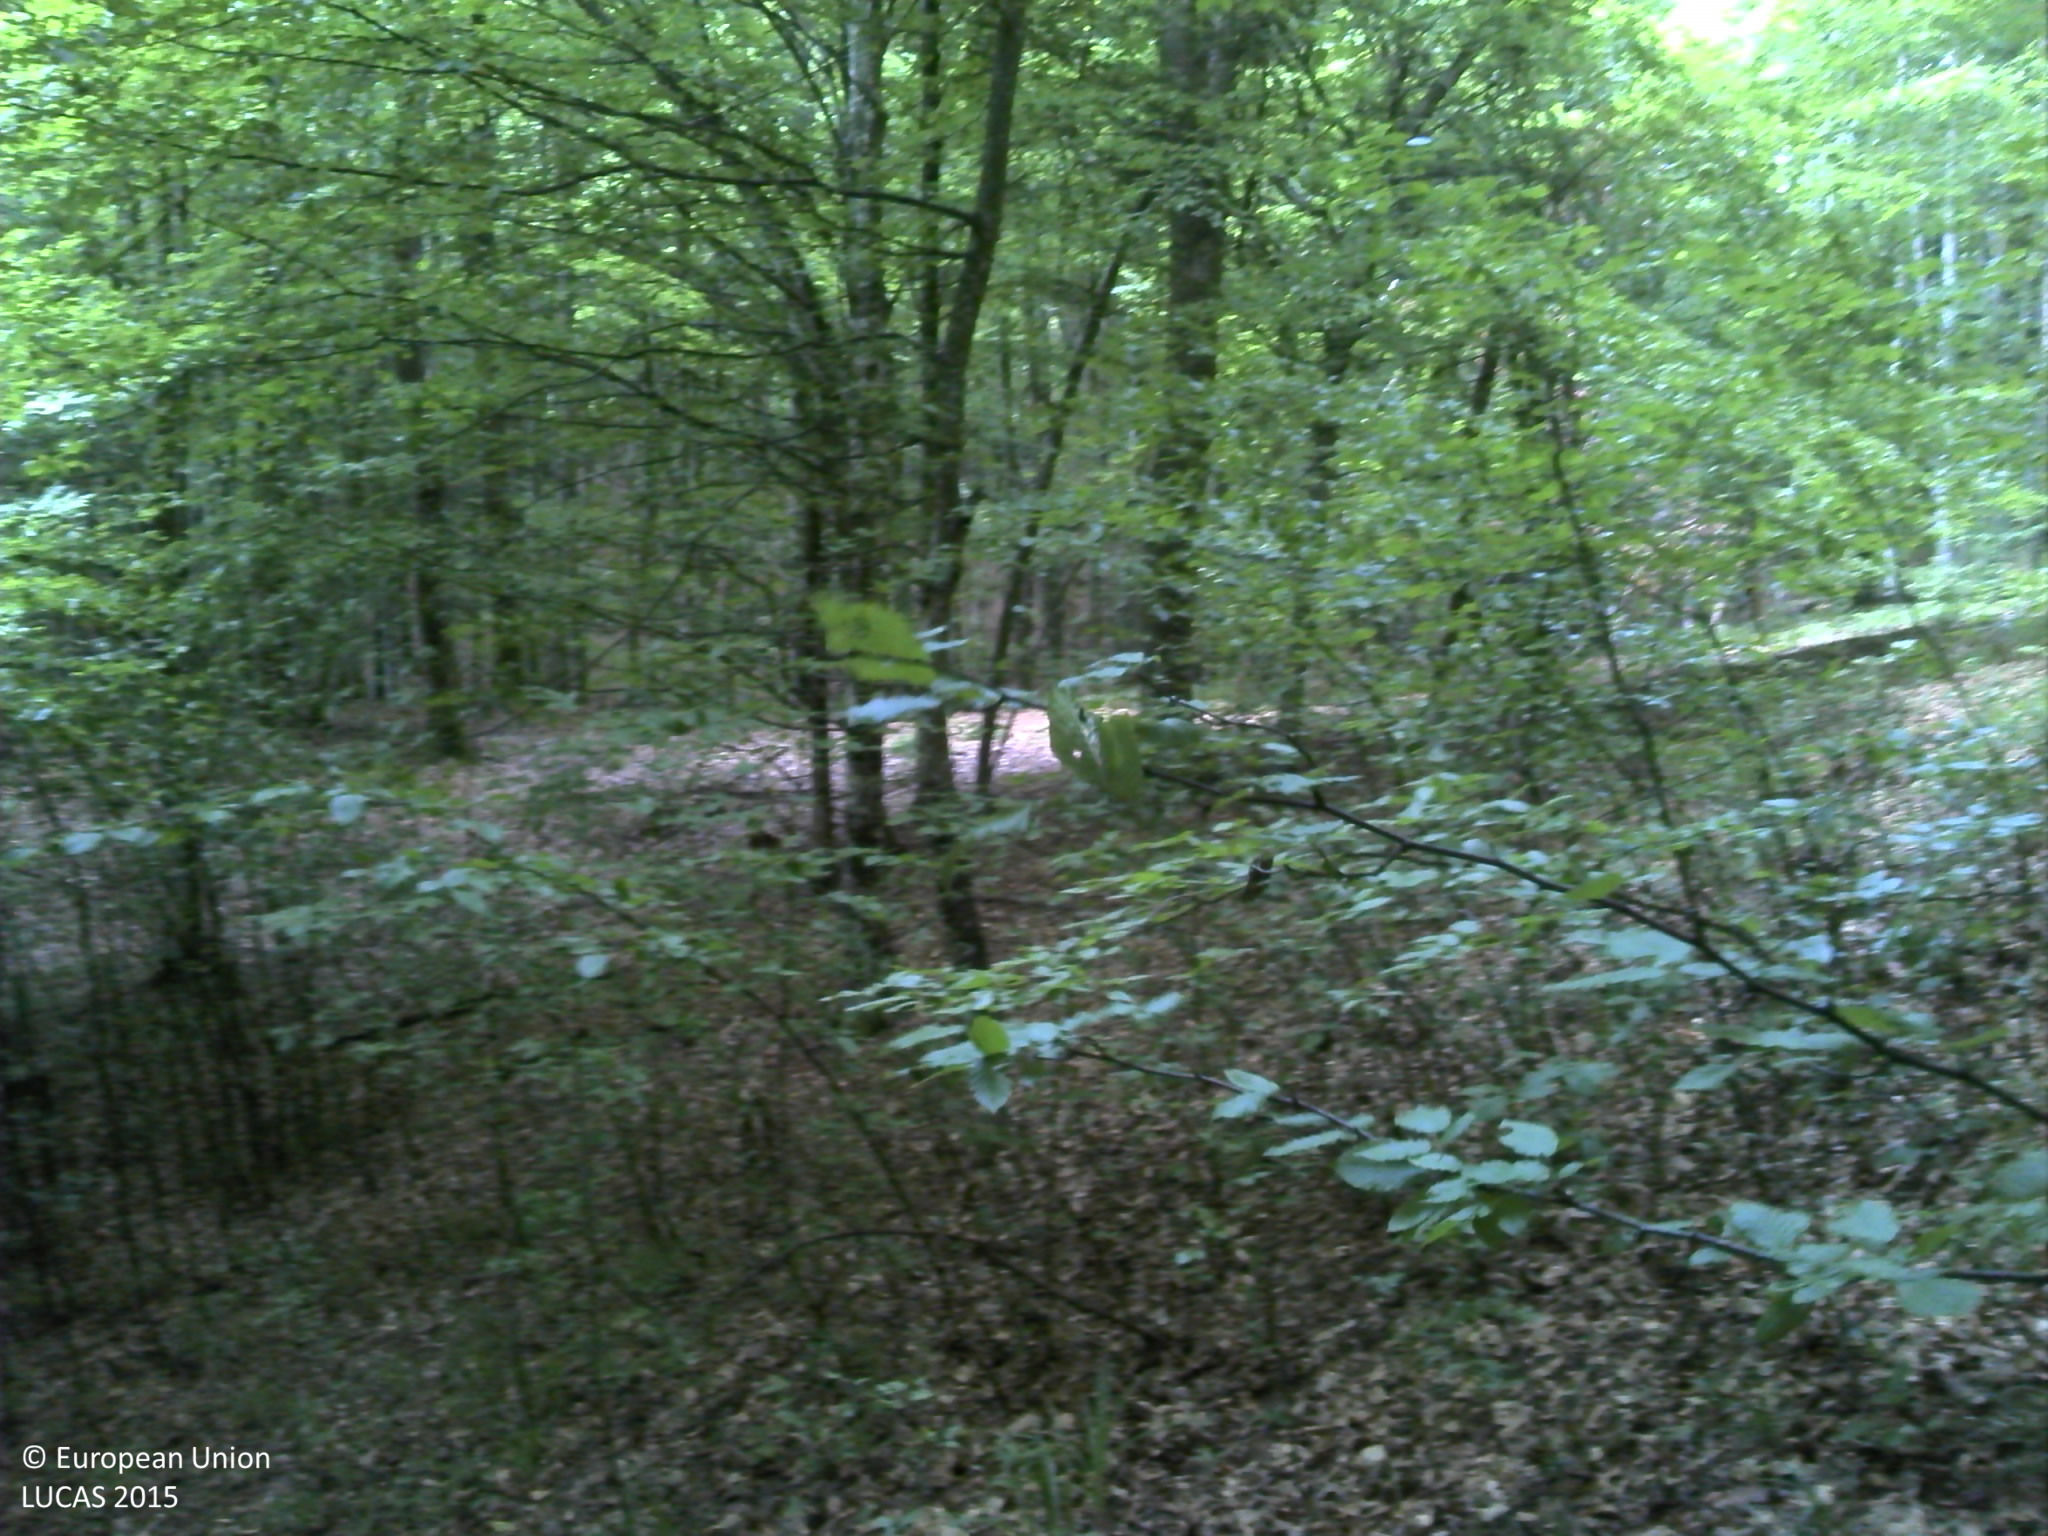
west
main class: Woodland
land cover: Broadleaved woodland
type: beech forest
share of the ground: > 75 %
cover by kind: broadleaved forest trees 80 %, lichens and mosses 20 %
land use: Forestry
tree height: > 5 m
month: June
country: HR
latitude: 45.4001
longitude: 17.2436
